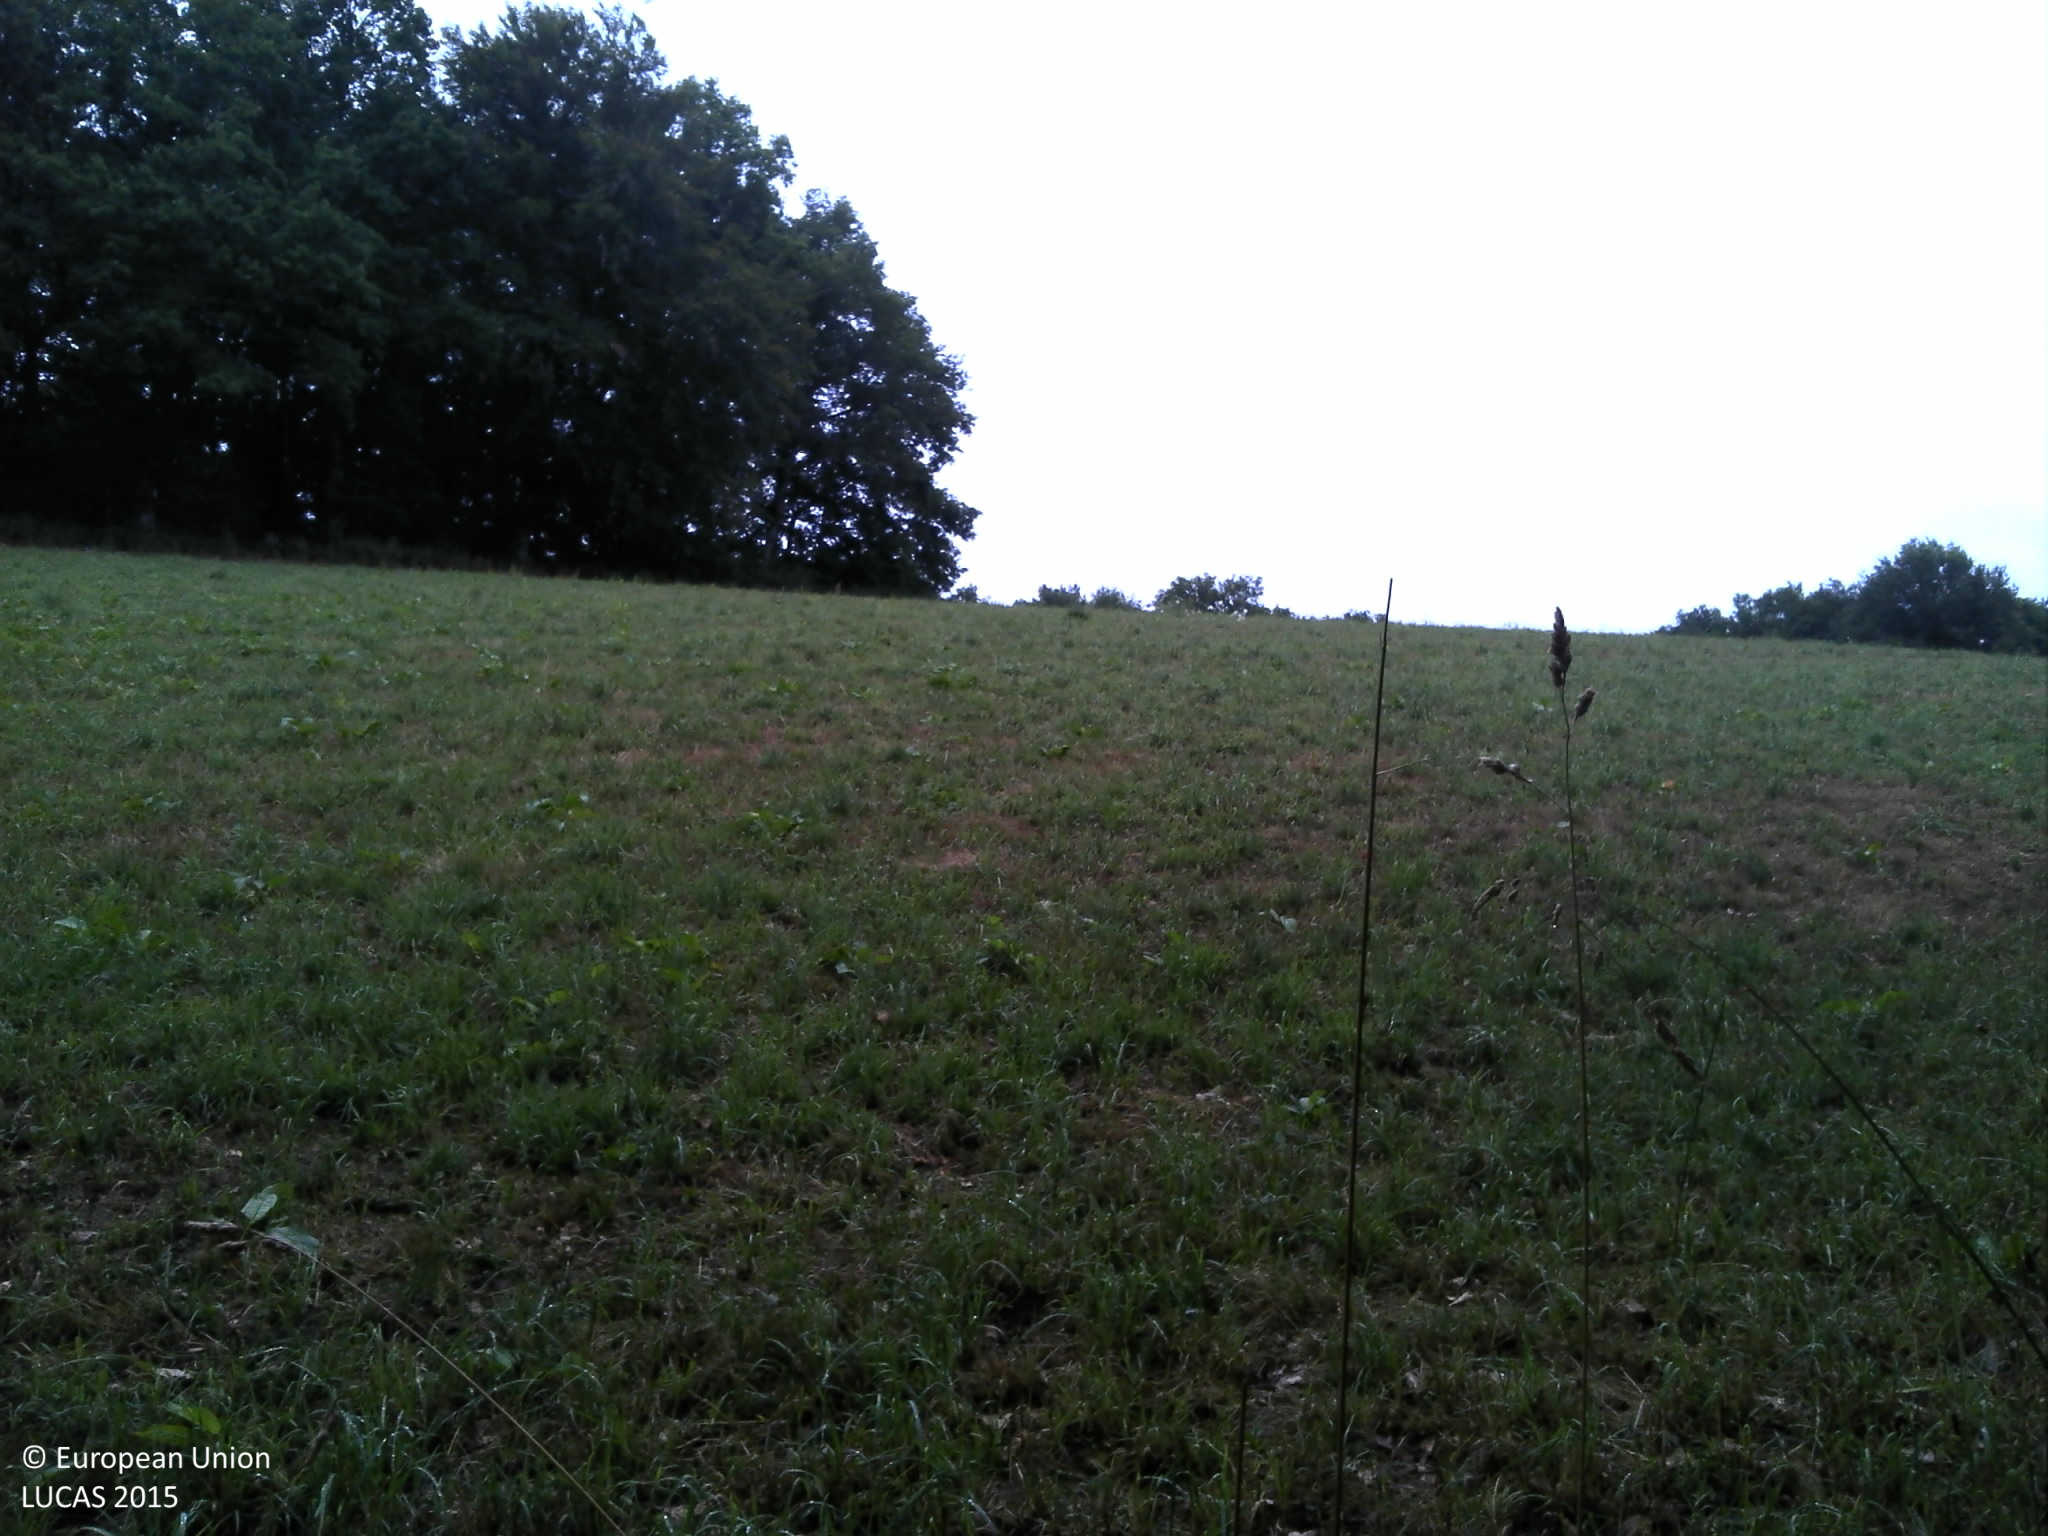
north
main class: Grassland
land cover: Grassland without tree/shrub cover
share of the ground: > 75 %
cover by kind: herbaceous plants 90 %, unconsolidated bare surface 10 %
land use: Agriculture (excluding fallow land and kitchen gardens)
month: August
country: FR
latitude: 45.4306
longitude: 2.4187
